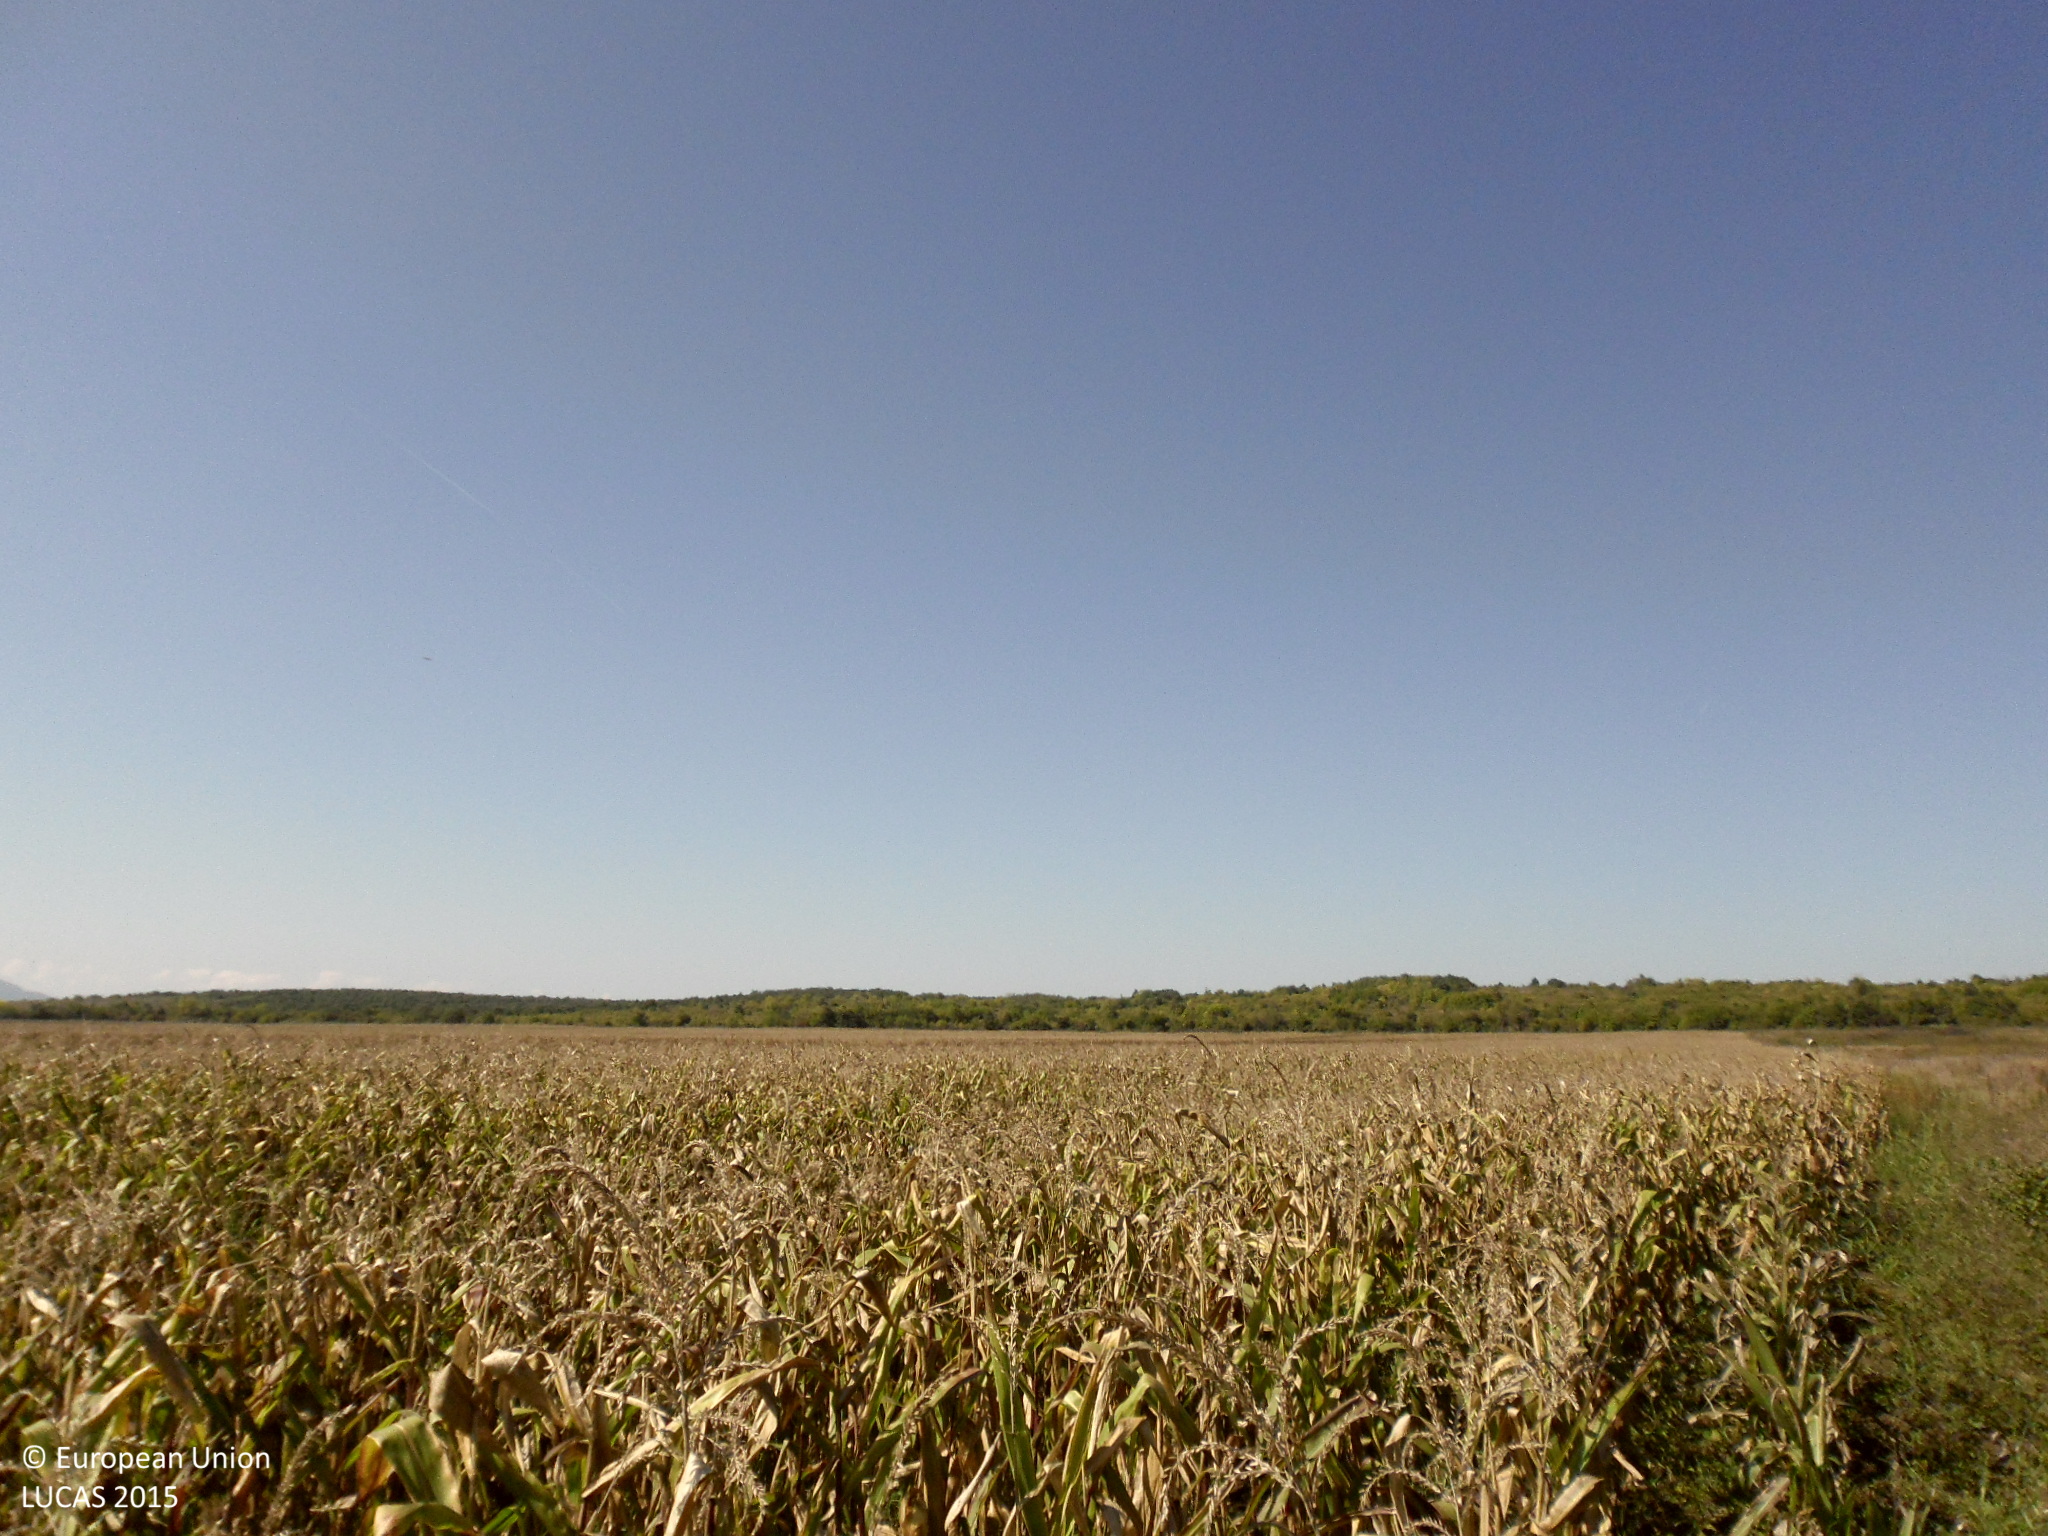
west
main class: Cropland
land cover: Maize
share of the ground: > 75 %
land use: Agriculture (excluding fallow land and kitchen gardens)
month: October
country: BG
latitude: 43.6549
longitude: 22.8699
